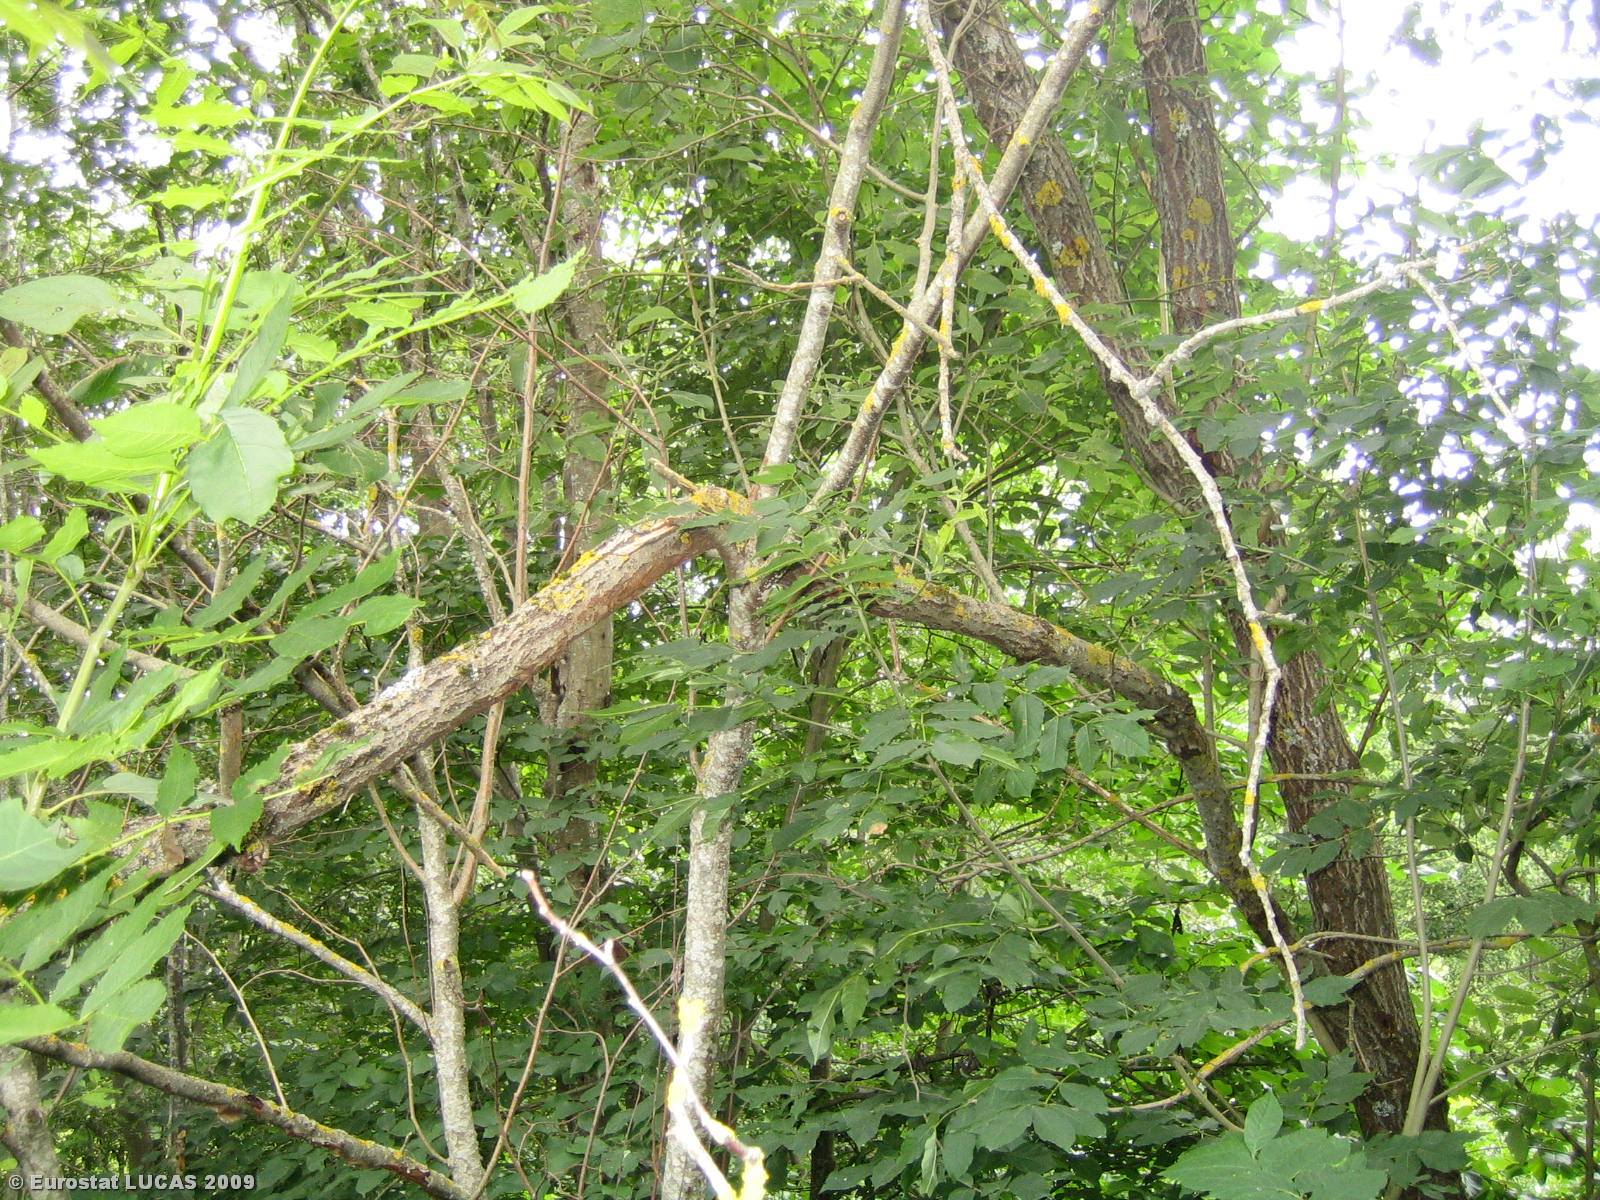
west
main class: Woodland
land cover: Broadleaved woodland
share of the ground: > 75 %
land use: Forestry
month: July
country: LT
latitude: 55.4562
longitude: 25.5110
